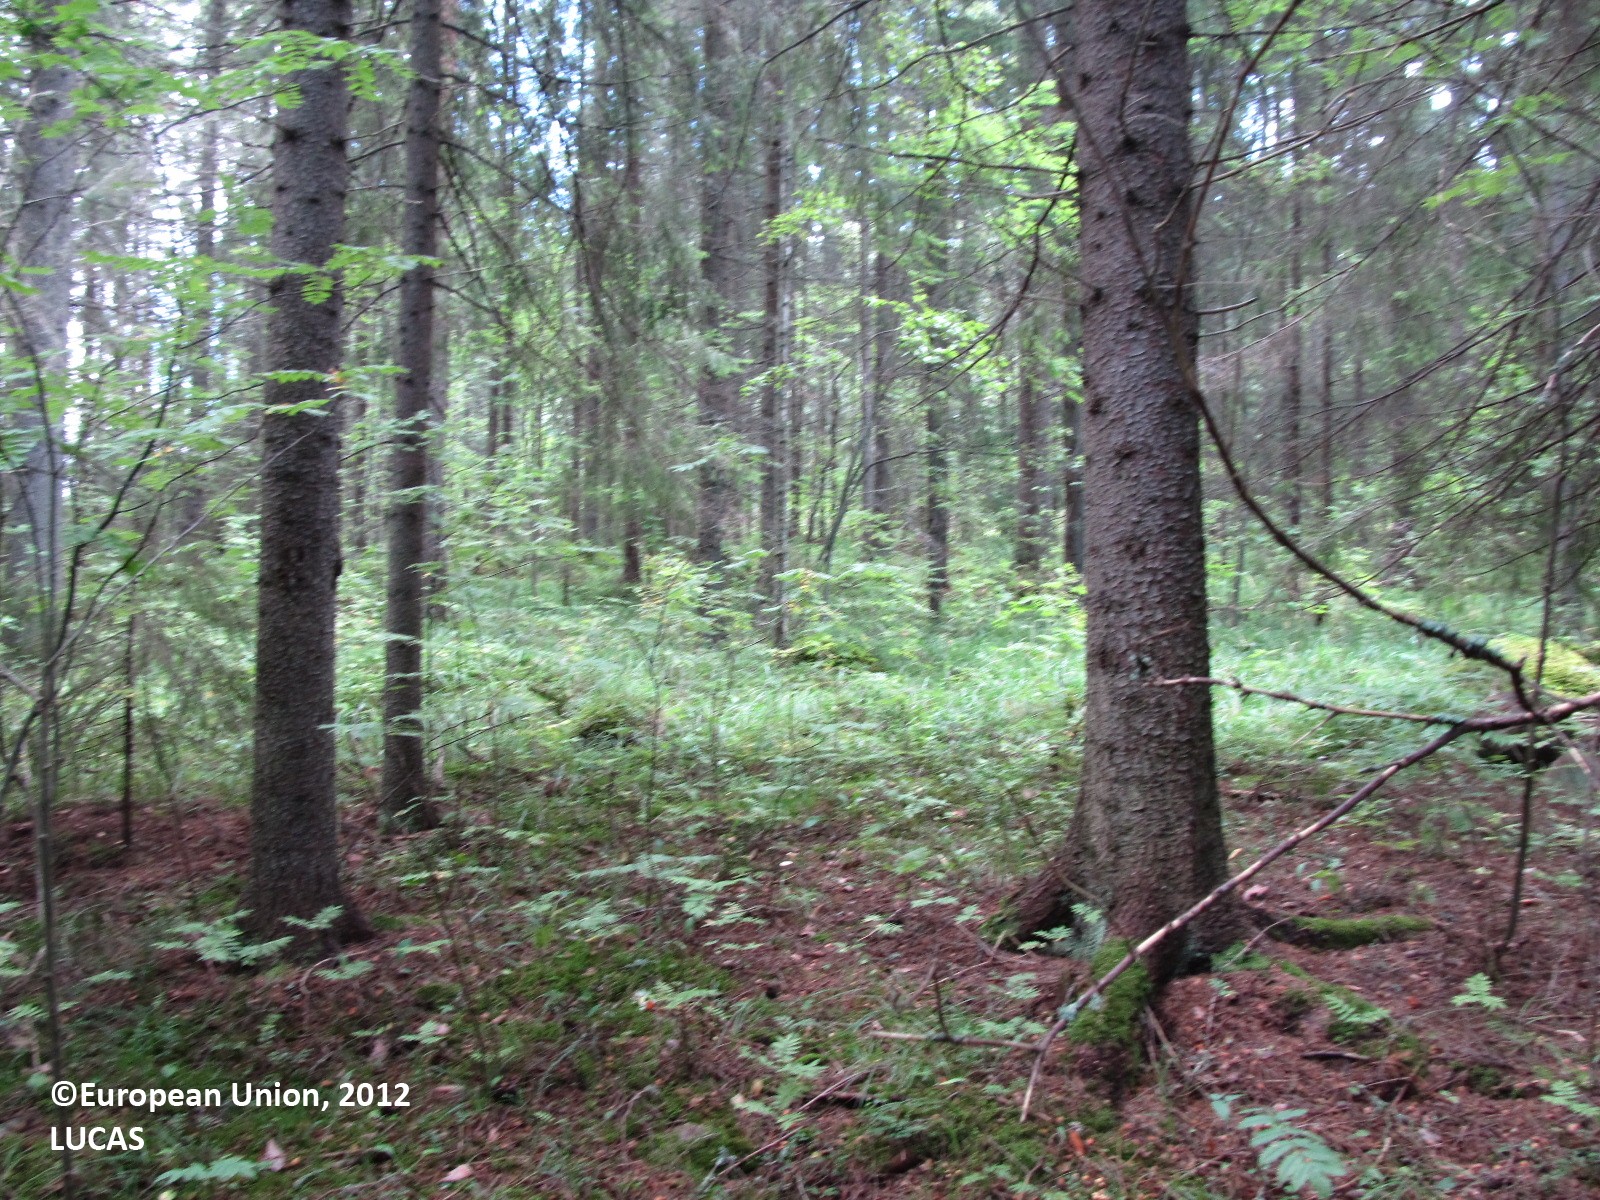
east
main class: Woodland
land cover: Spruce dominated coniferous woodland
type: boreal forest
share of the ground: 25 - 50 %
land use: Forestry
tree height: > 5 m
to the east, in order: Spruce dominated coniferous woodland; Ditches and canals; Grassland without tree/shrub cover; Paved roads, cycling and walking lanes; Grassland without tree/shrub cover; Ditches and canals; Spruce dominated coniferous woodland; Electric lines; Spruce dominated coniferous woodland
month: August
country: FI
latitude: 62.8877
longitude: 27.8562
